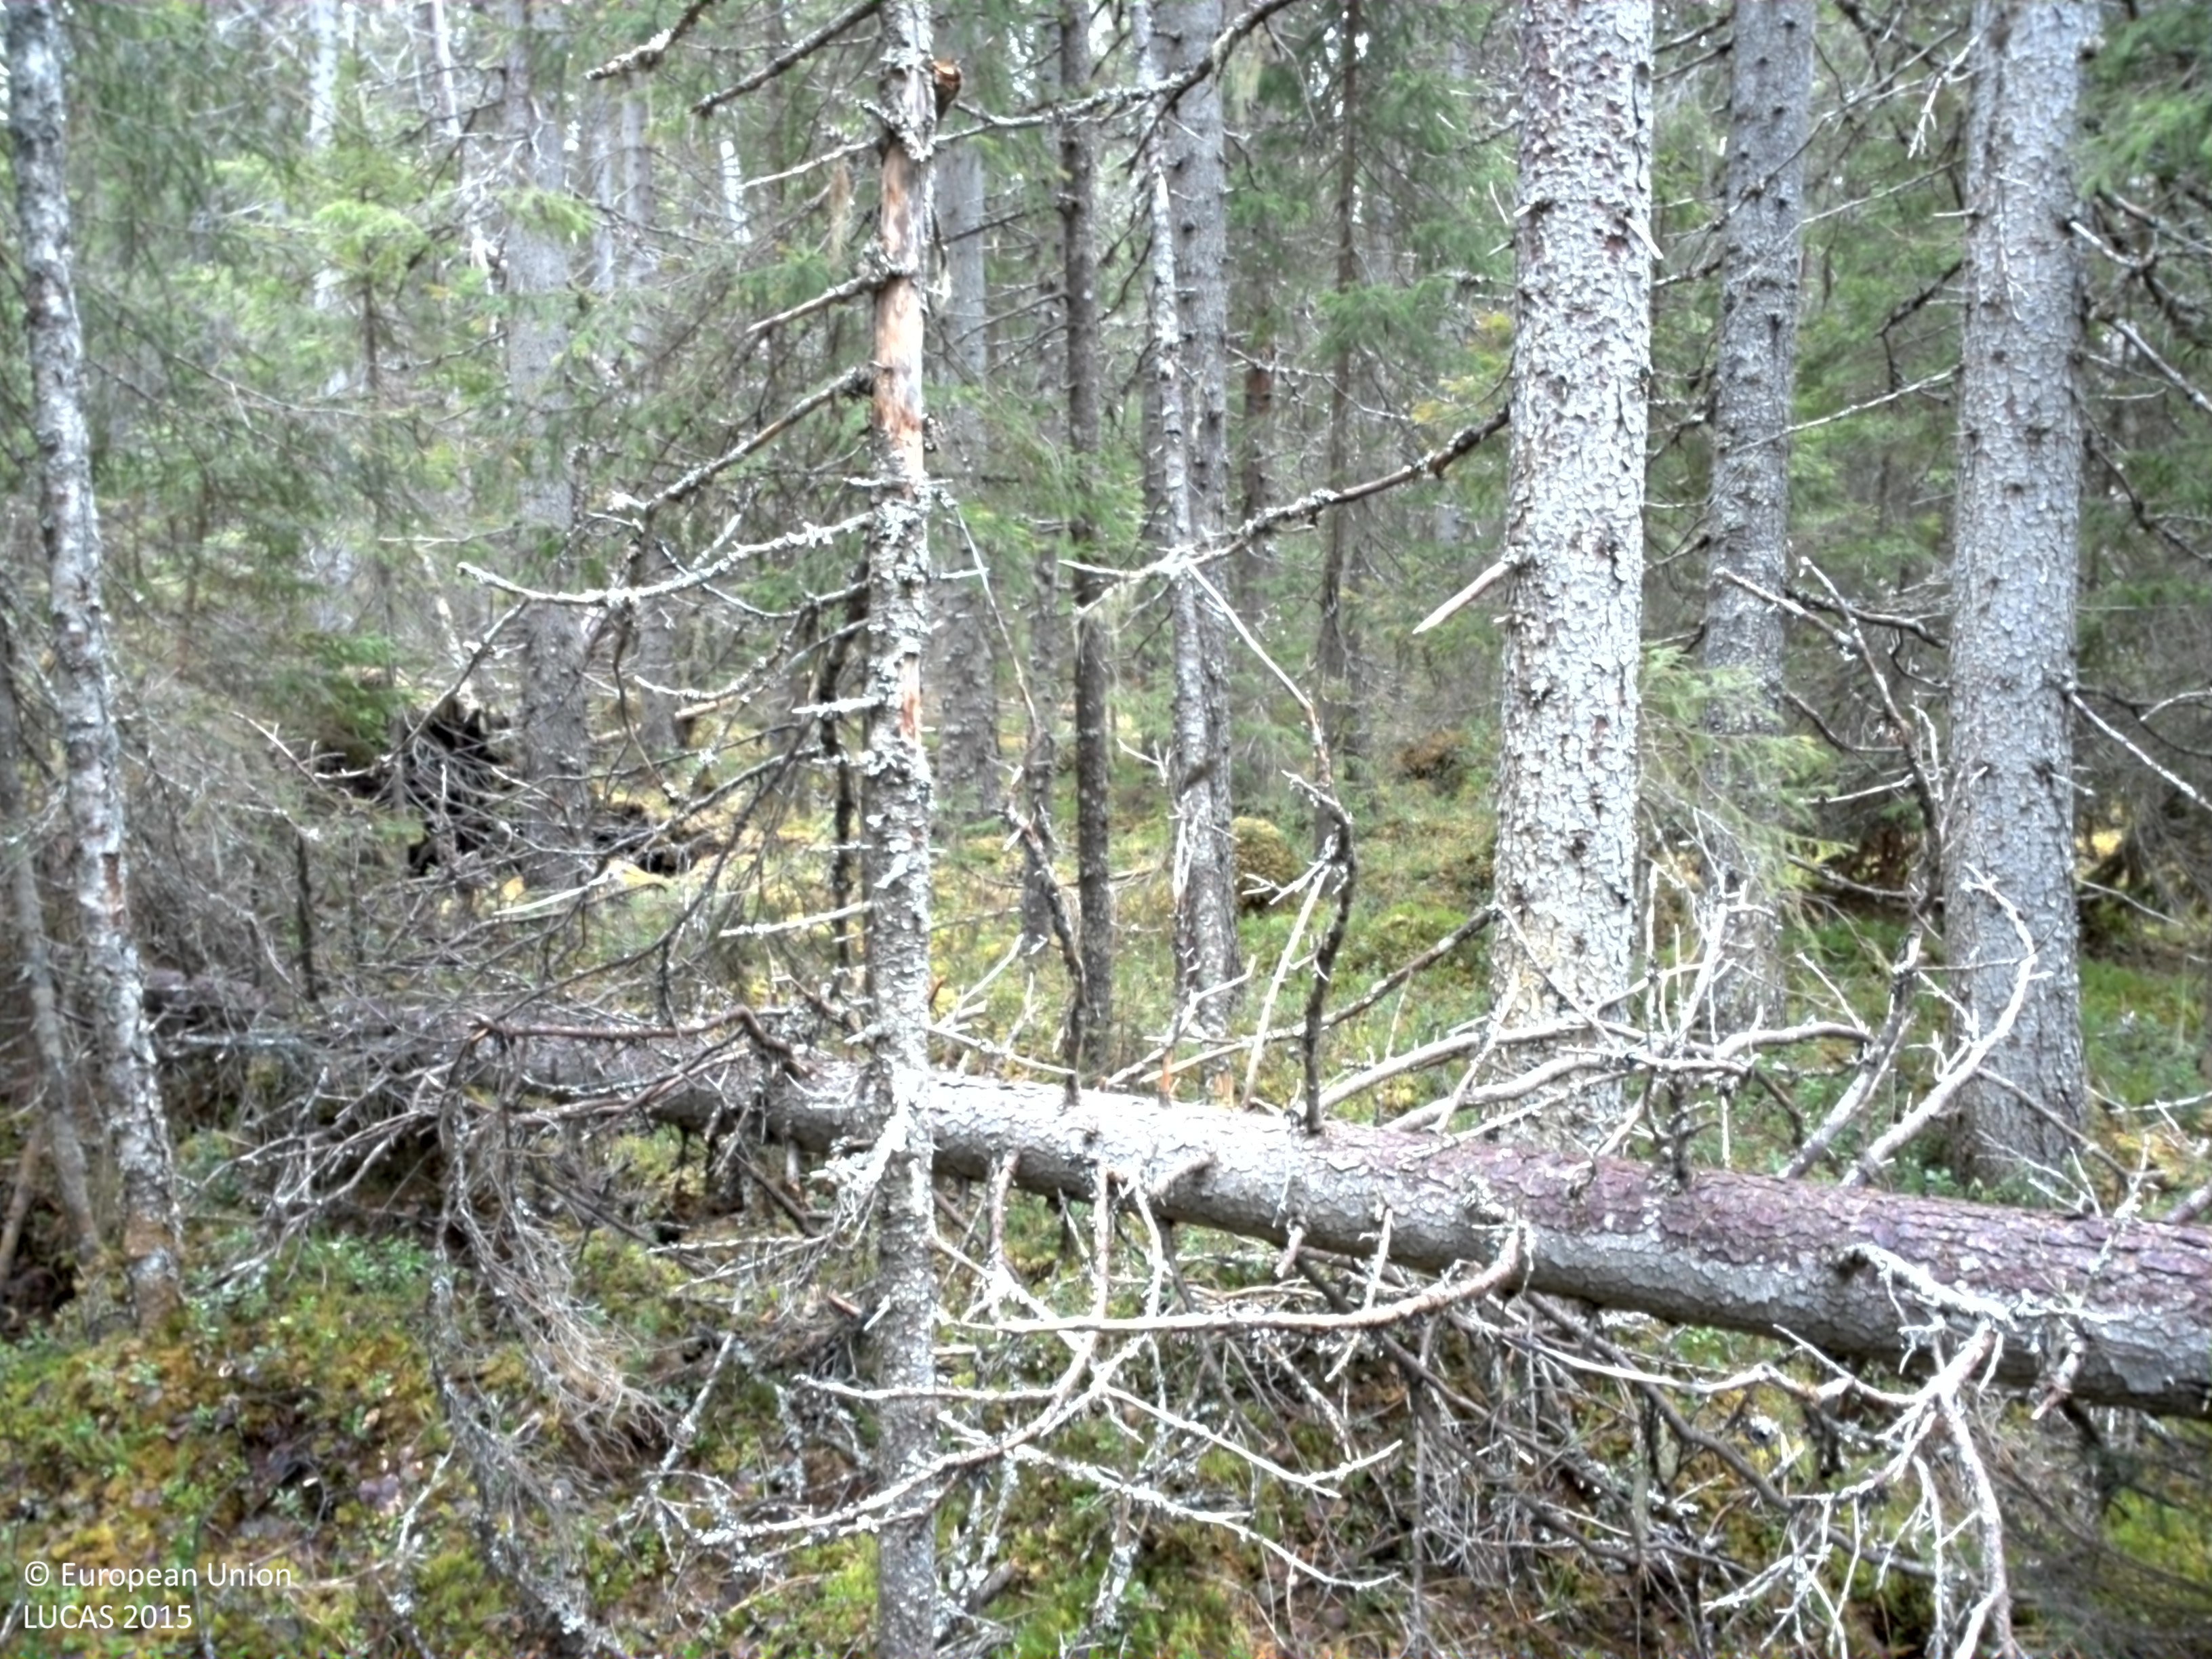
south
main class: Woodland
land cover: Spruce dominated coniferous woodland
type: boreal forest
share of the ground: > 75 %
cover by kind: coniferous forest trees 80 %, lichens and mosses 15 %, broadleaved forest trees 5 %
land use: Forestry
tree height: > 5 m
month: May
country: SE
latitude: 63.3598
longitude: 13.7591
